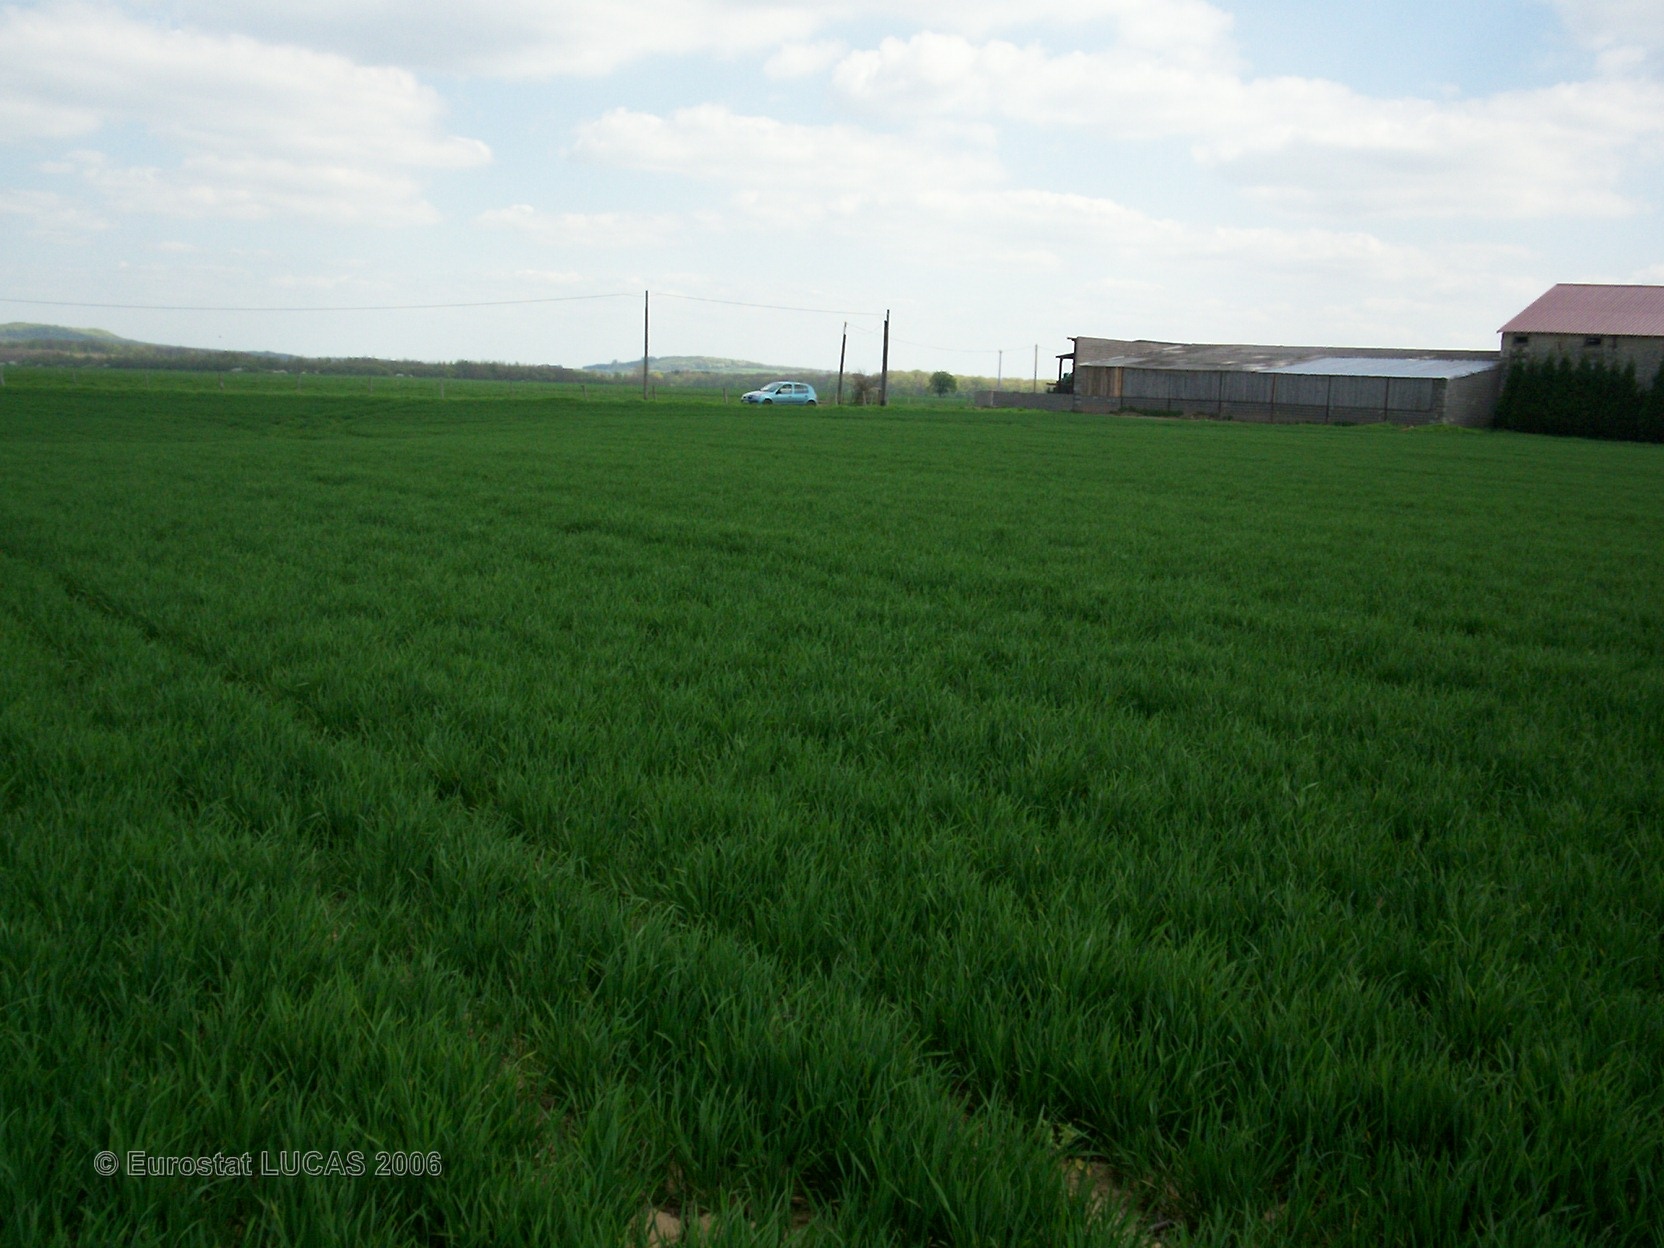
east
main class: Cropland
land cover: Common wheat
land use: Agriculture (excluding fallow land and kitchen gardens)
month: April
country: FR
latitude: 49.0035
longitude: 6.7332
